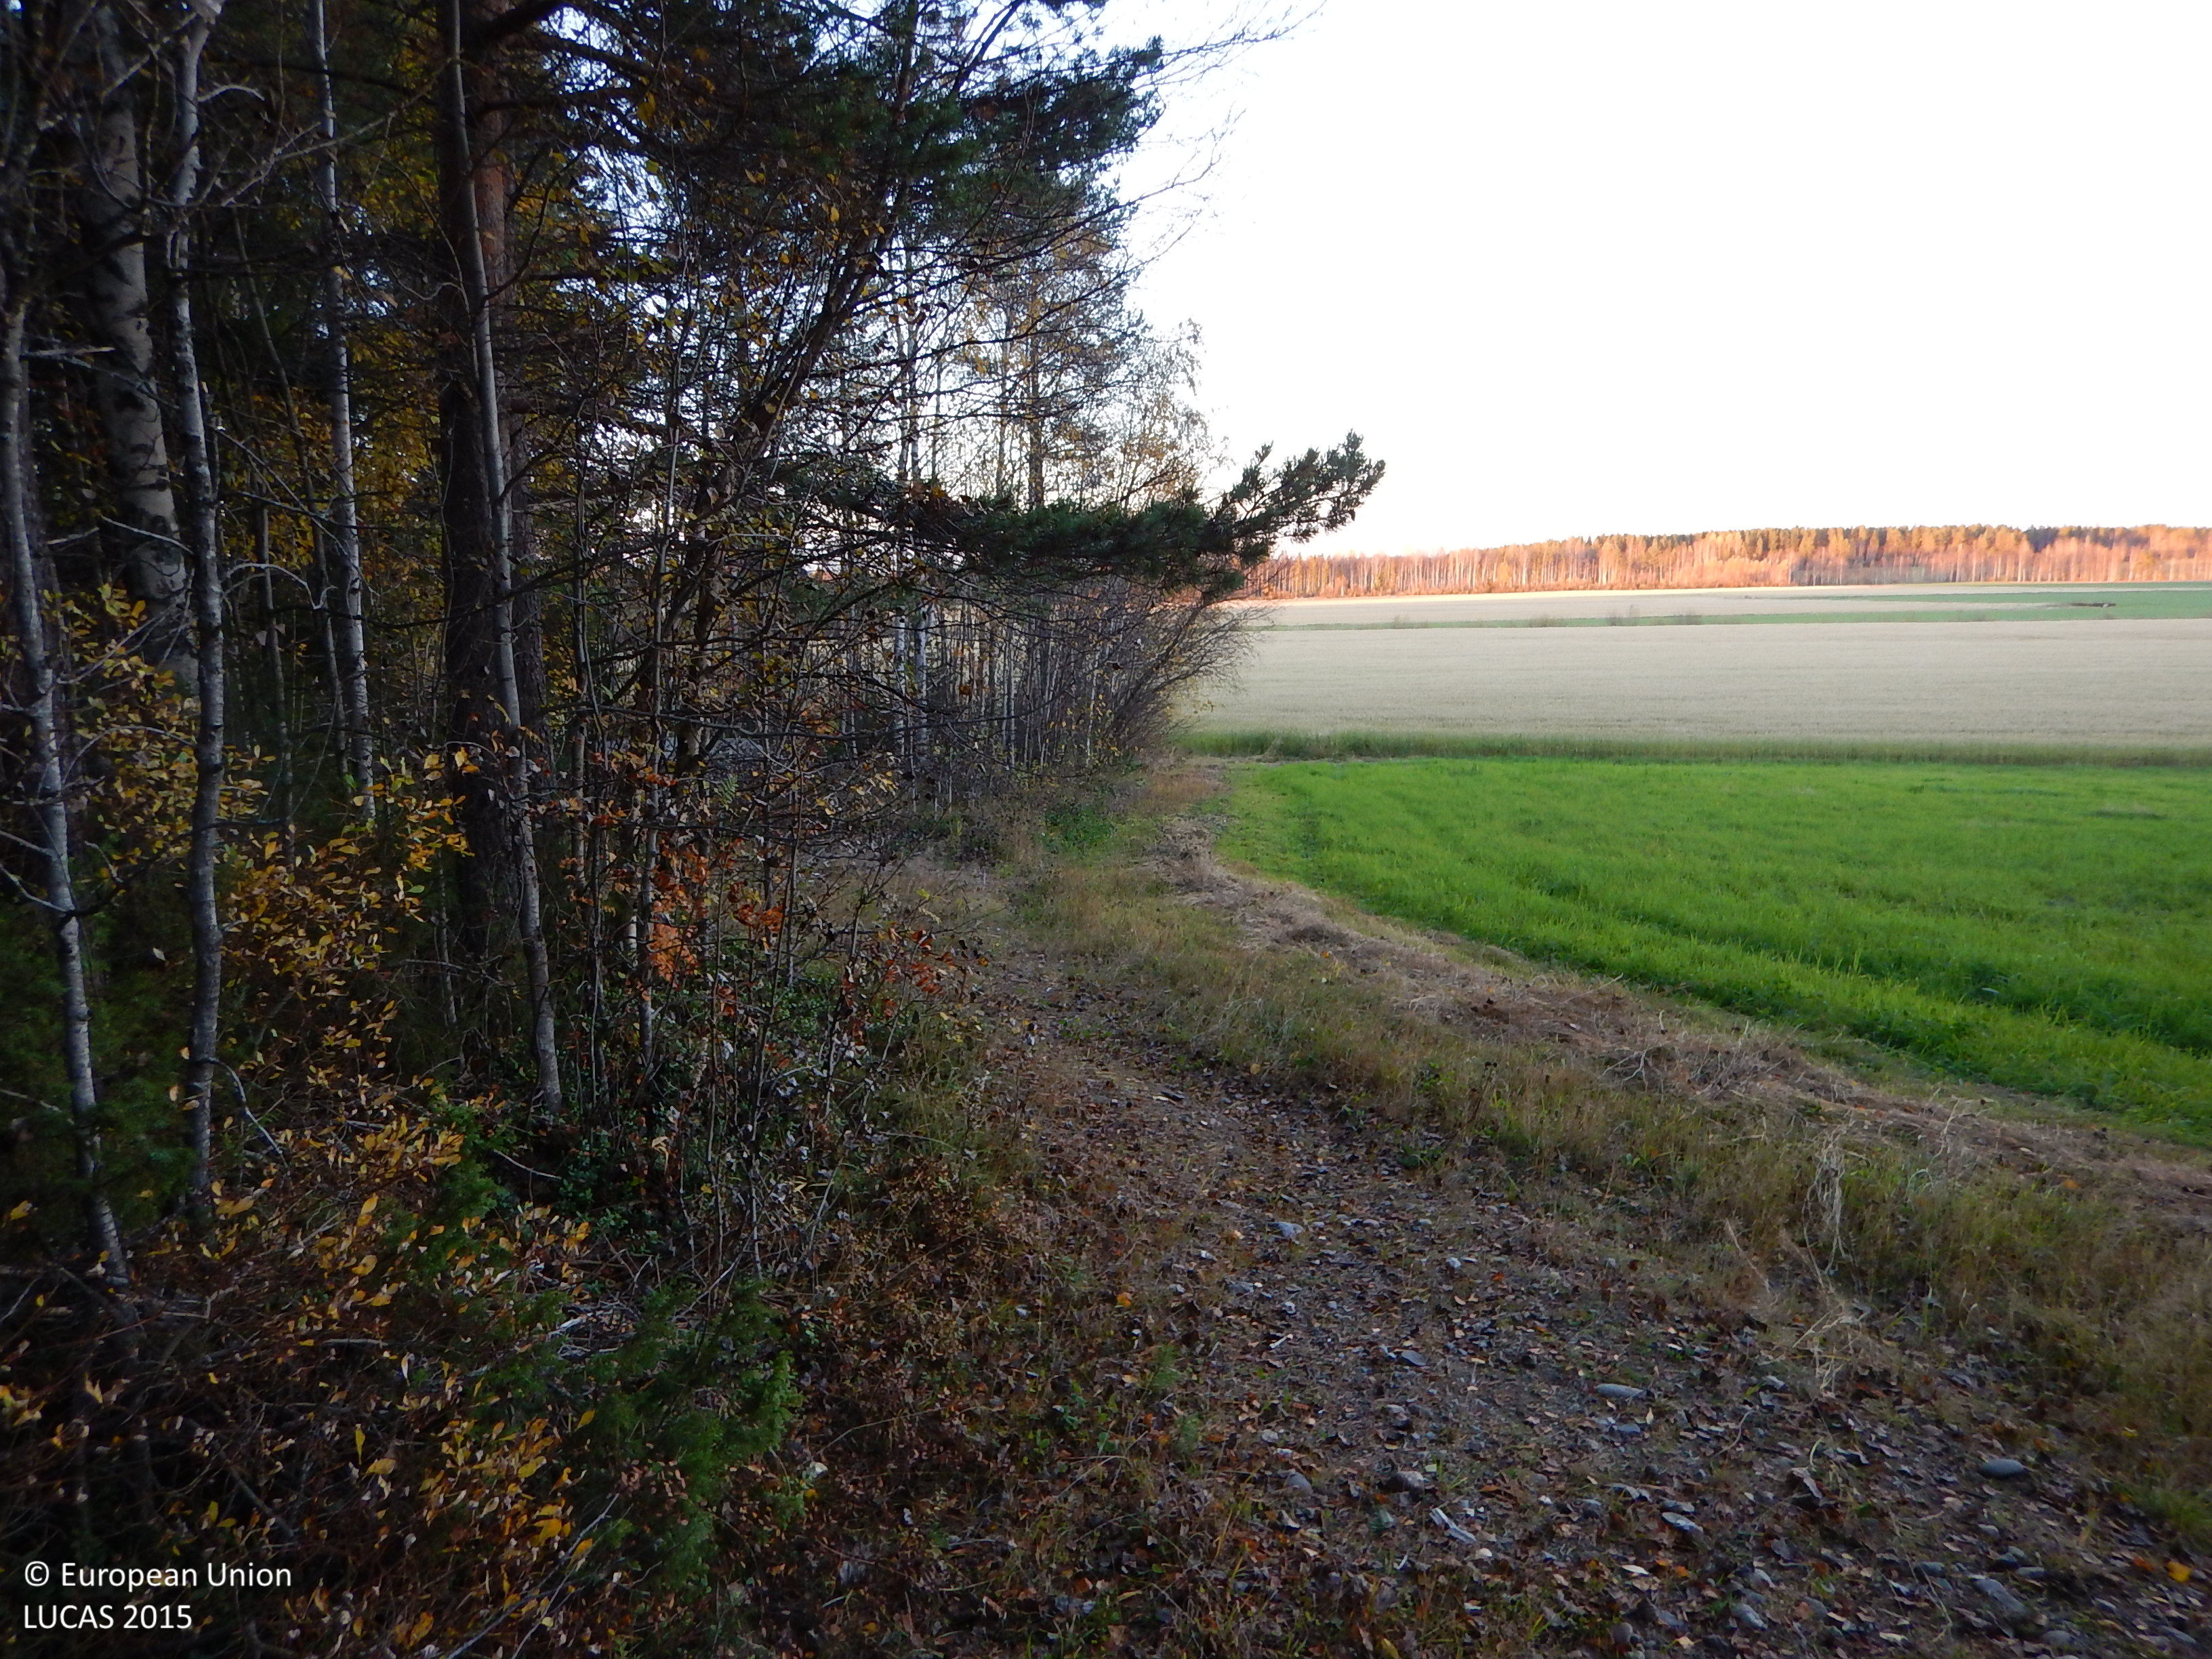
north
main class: Woodland
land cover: Pine dominated mixed woodland
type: boreal forest
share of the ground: 50 - 75 %
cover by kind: coniferous forest trees 40 %, broadleaved forest trees 20 %, shrubs 20 %, herbaceous plants 10 %, lichens and mosses 10 %
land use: Forestry
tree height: > 5 m
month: October
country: SE
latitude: 64.8876
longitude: 21.0643
